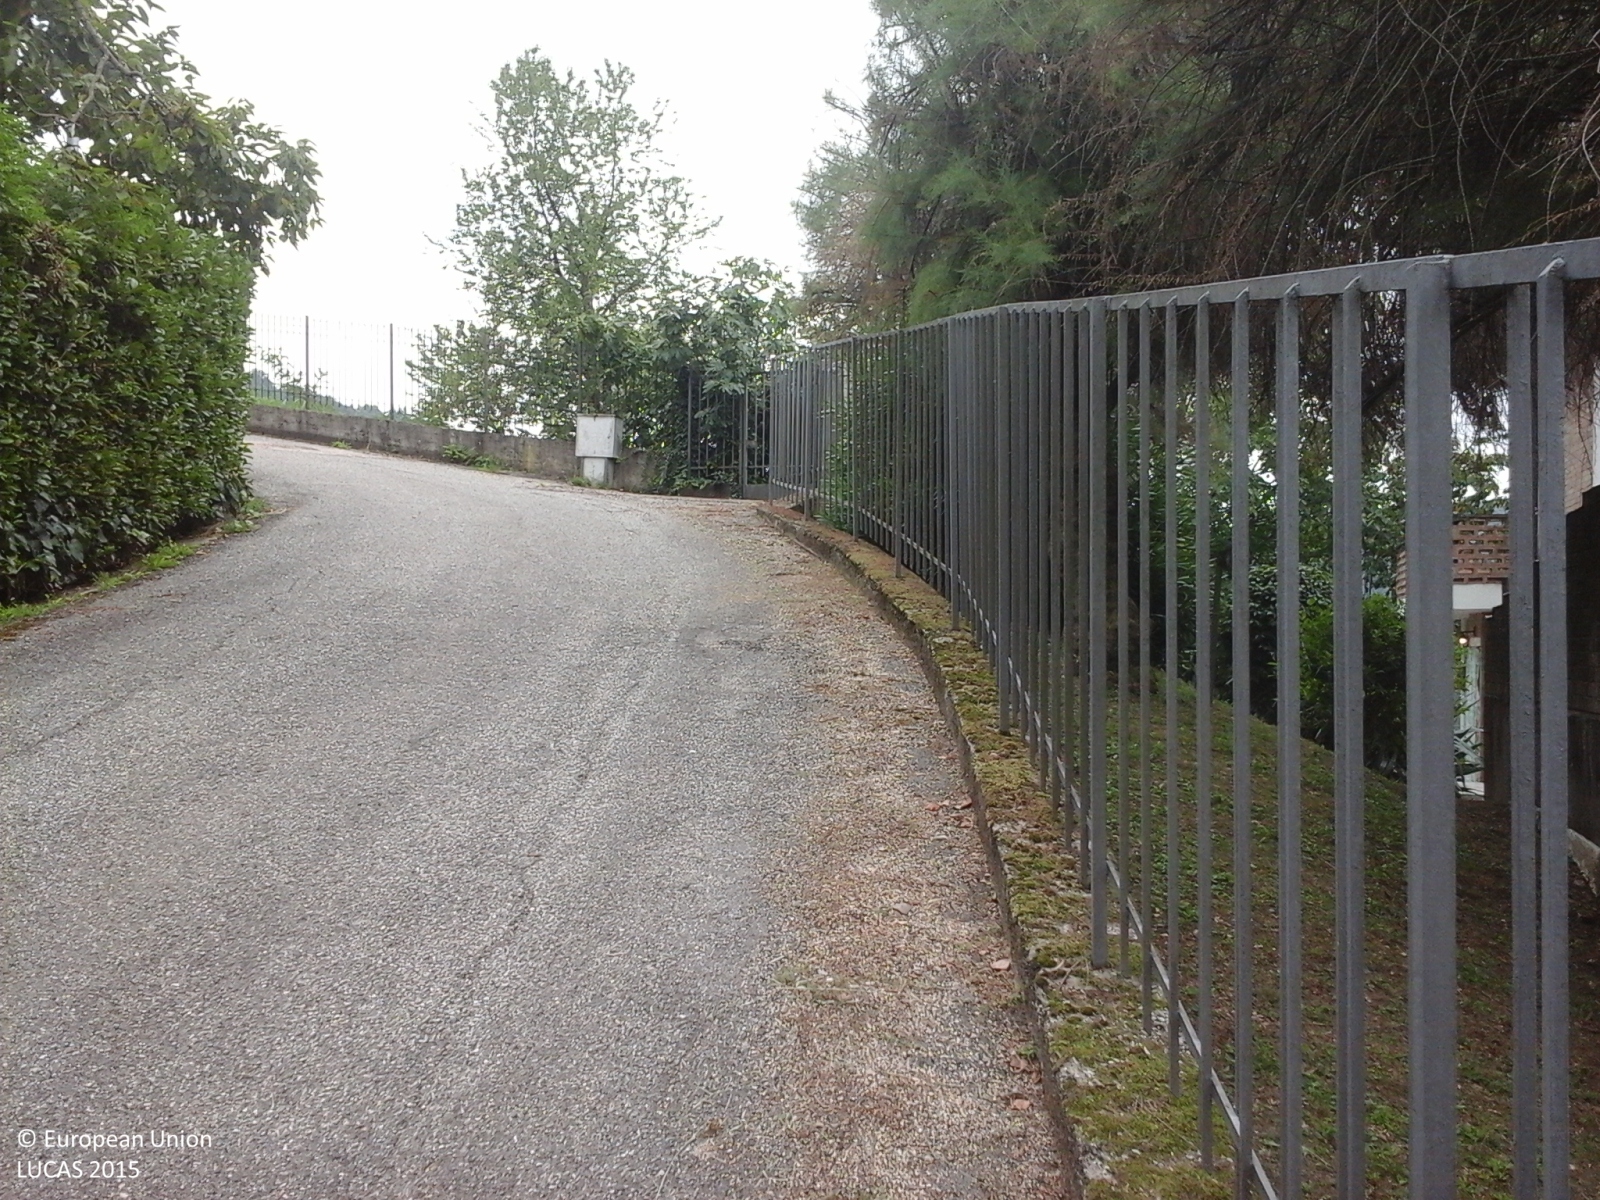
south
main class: Woodland
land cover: Other coniferous woodland
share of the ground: > 75 %
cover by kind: coniferous forest trees 50 %, herbaceous plants 30 %, broadleaved forest trees 10 %, shrubs 10 %
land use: Residential
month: September
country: IT
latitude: 45.0478
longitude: 7.7567
